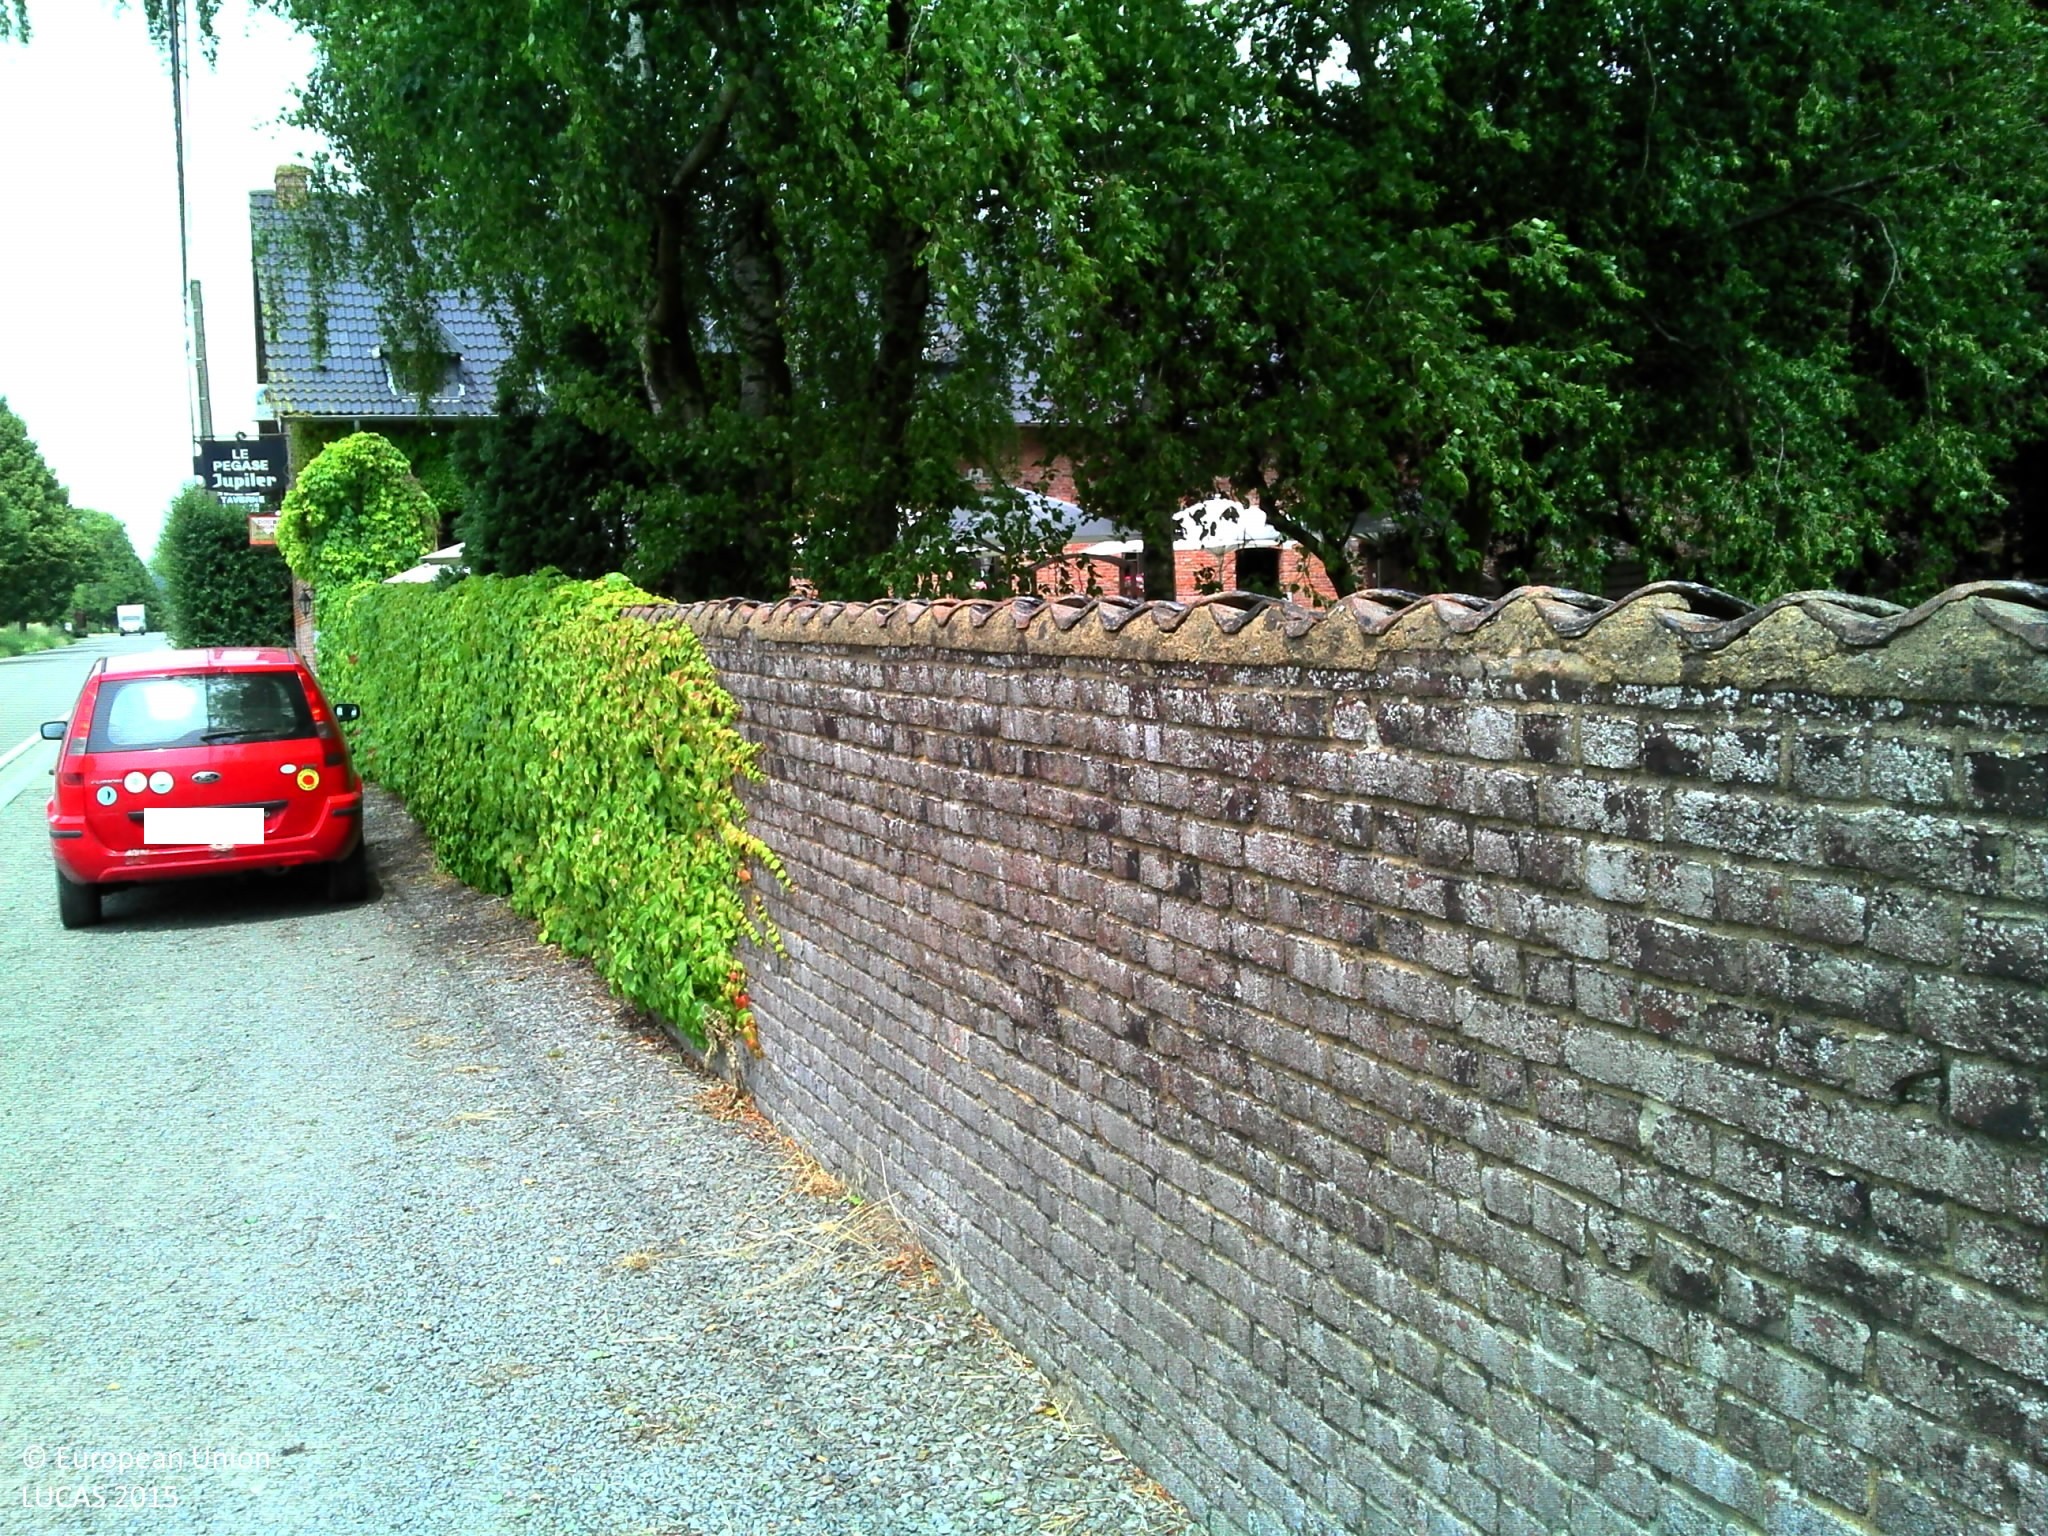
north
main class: Grassland
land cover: Grassland without tree/shrub cover
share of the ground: > 75 %
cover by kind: herbaceous plants 100 %
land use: Amenities, museums, leisure
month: June
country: BE
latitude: 50.6429
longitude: 3.7286
